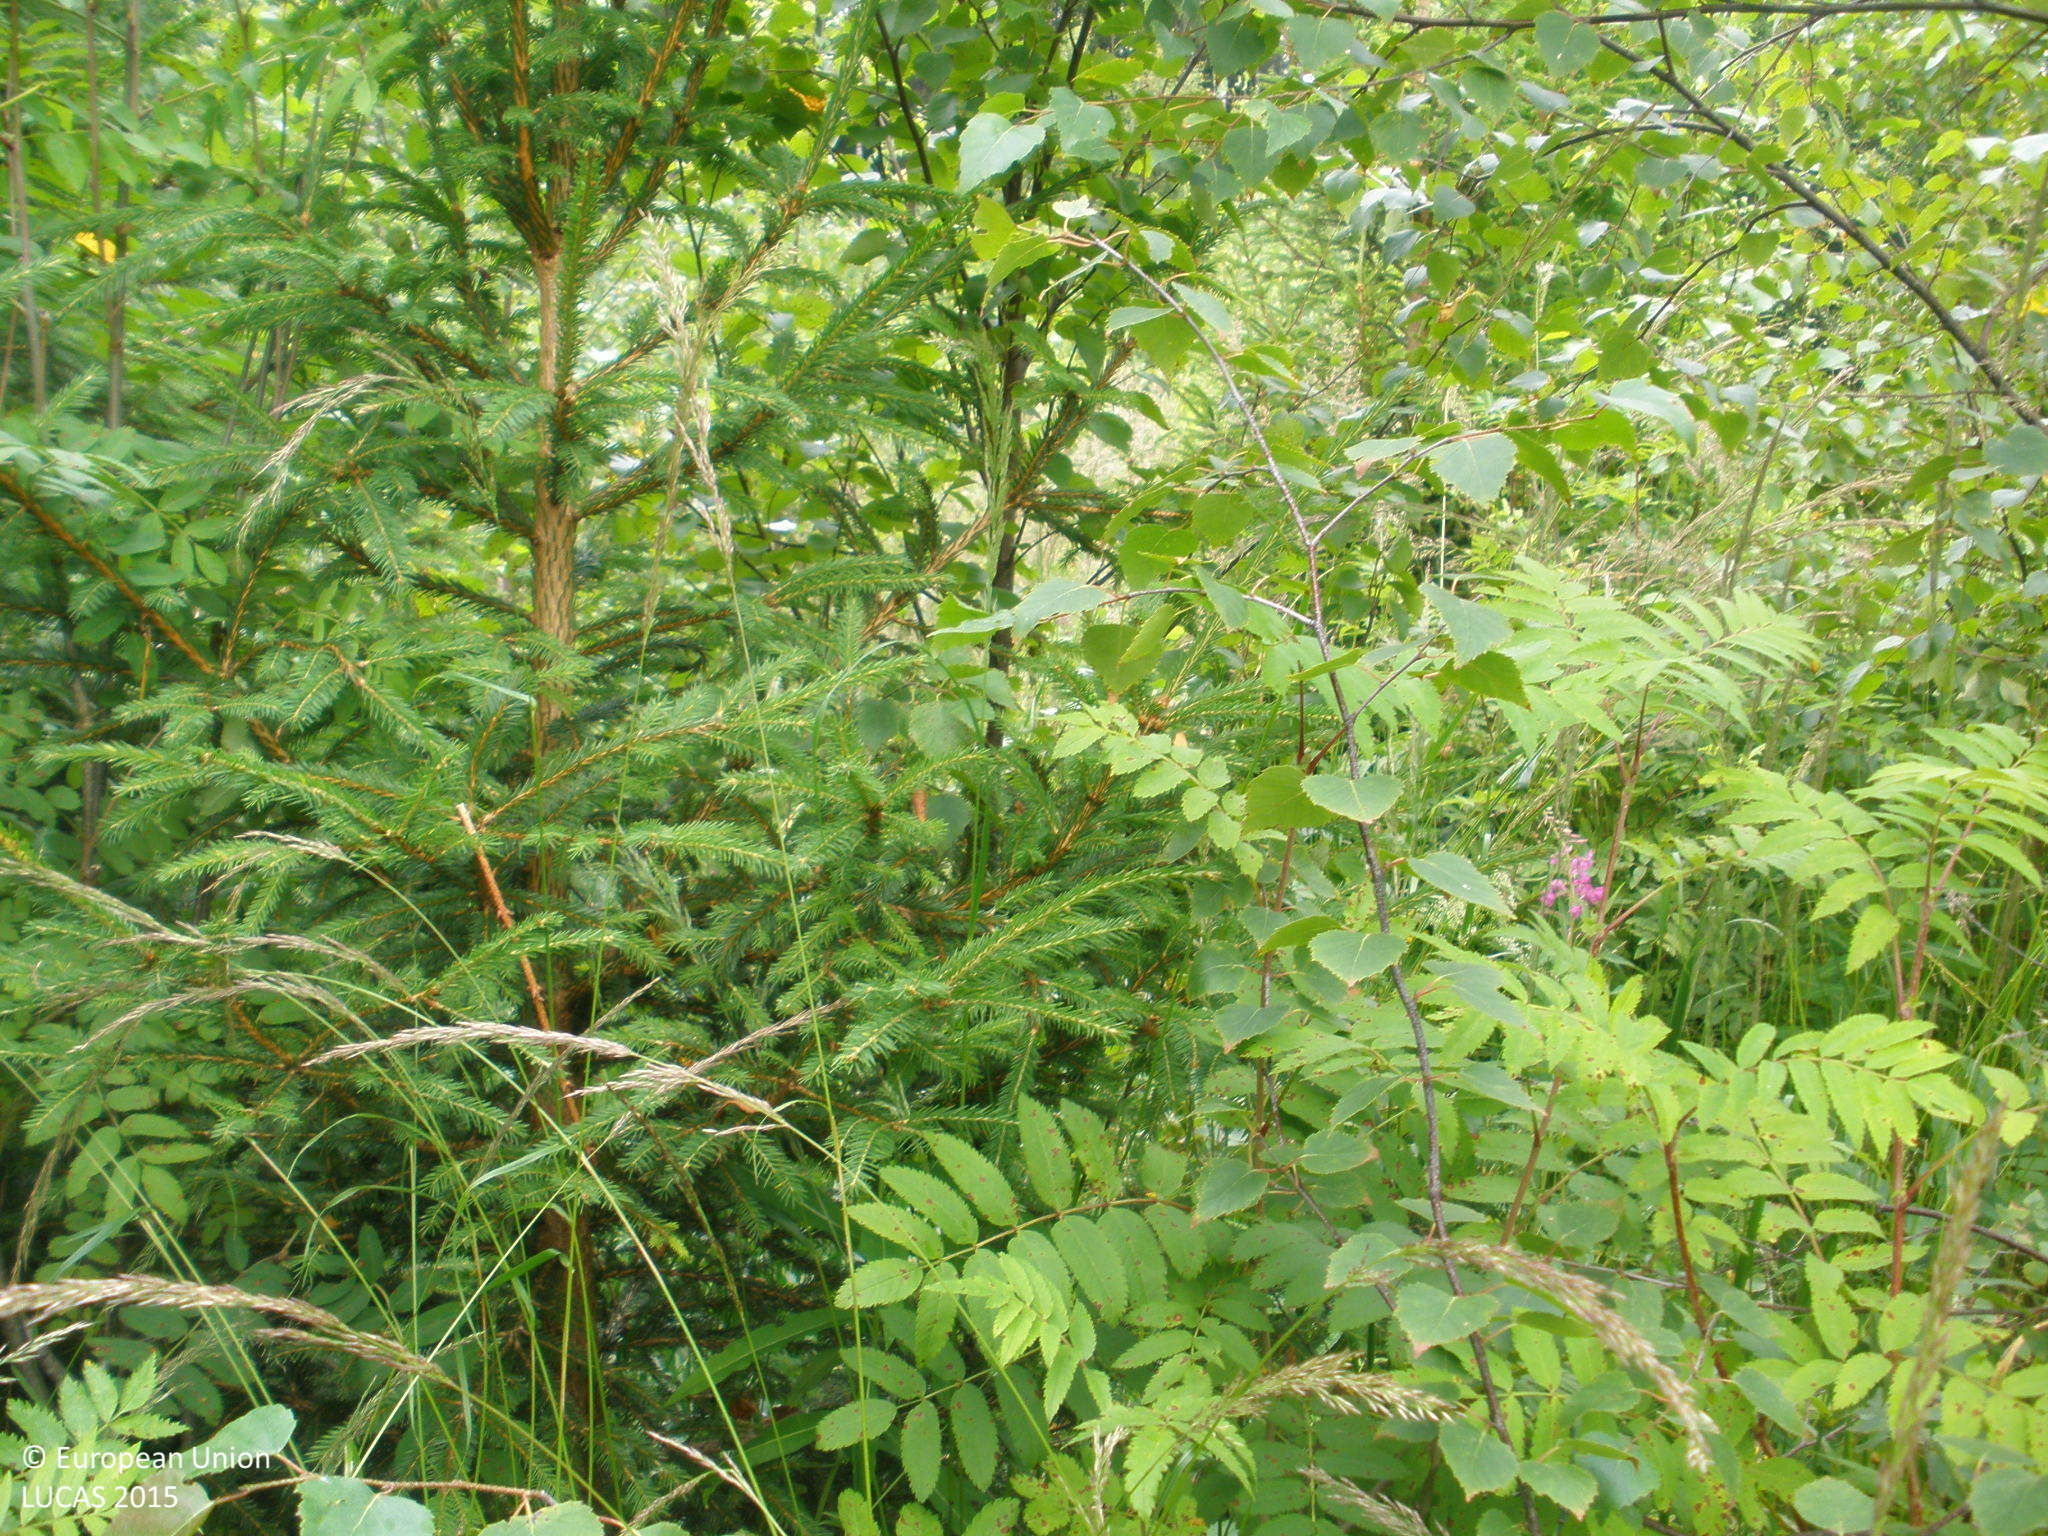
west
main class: Woodland
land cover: Other mixed woodland
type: boreal forest
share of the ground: 25 - 50 %
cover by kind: herbaceous plants 40 %, coniferous forest trees 20 %, broadleaved forest trees 20 %, shrubs 20 %
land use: Forestry
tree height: < 5 m
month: July
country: FI
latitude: 61.0976
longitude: 25.1966
